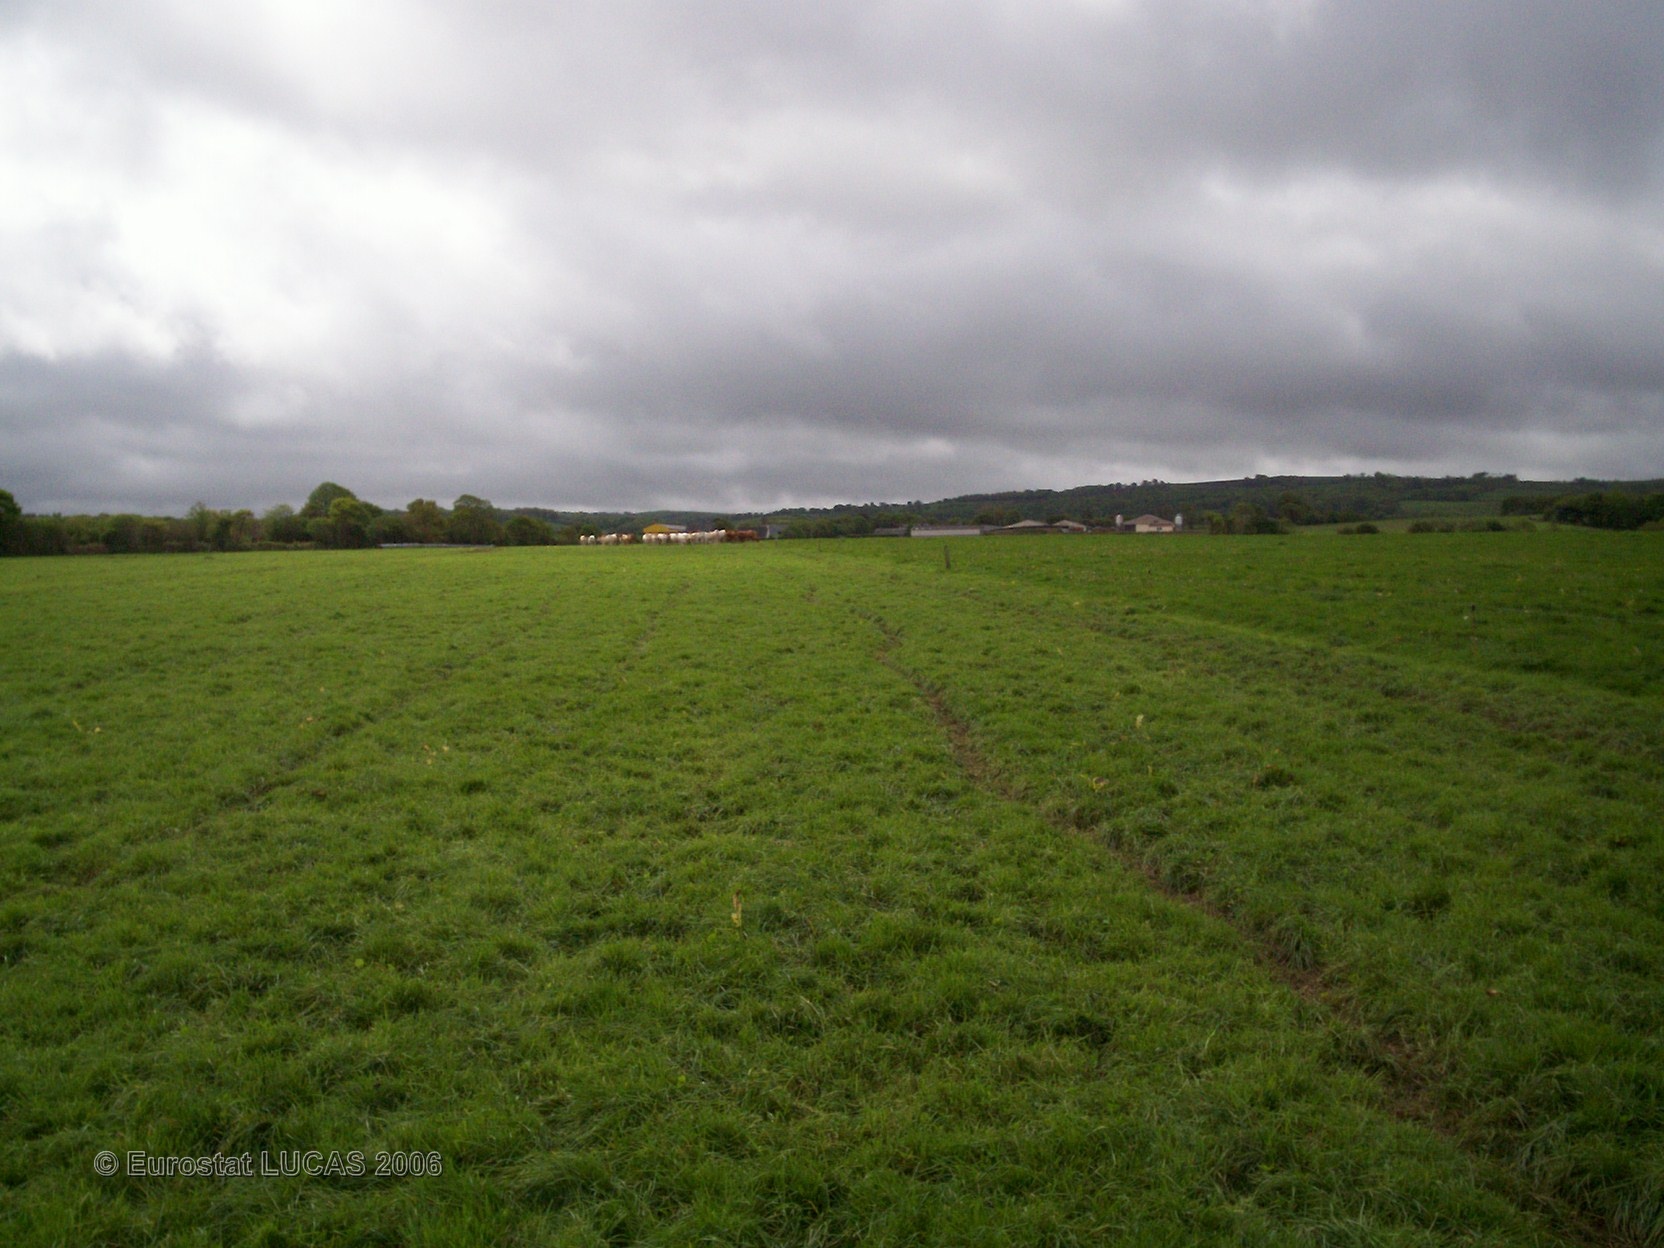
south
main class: Grassland
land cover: Grassland without tree/shrub cover
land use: Agriculture (excluding fallow land and kitchen gardens)
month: May
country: FR
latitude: 48.5110
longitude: -3.7145
